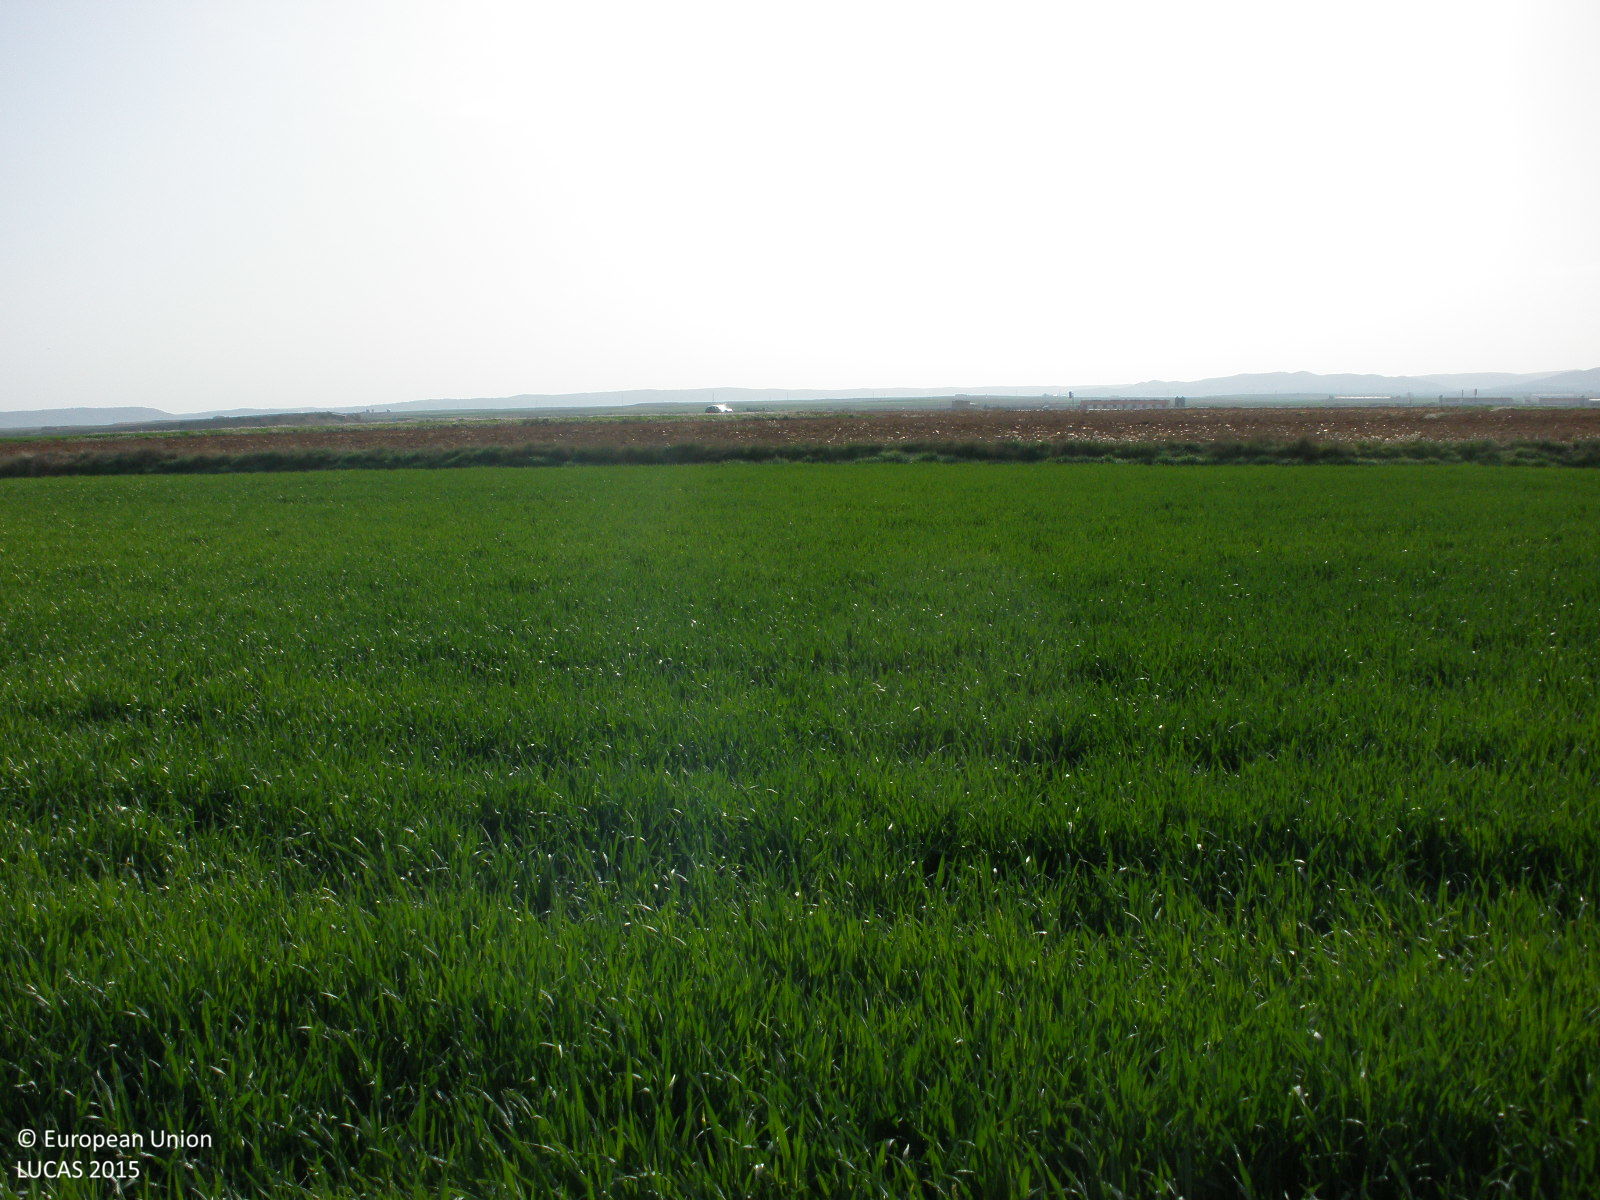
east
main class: Cropland
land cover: Common wheat
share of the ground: > 75 %
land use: Agriculture (excluding fallow land and kitchen gardens)
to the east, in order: Common wheat; Grass margins; Other bare soil; Grass margins; Other bare soil; Grass margins; Barley; Grass margins; Other bare soil; Grass margins; Spontaneously vegetated surfaces; Grass margins
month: April
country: ES
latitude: 40.8505
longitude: -1.3217
